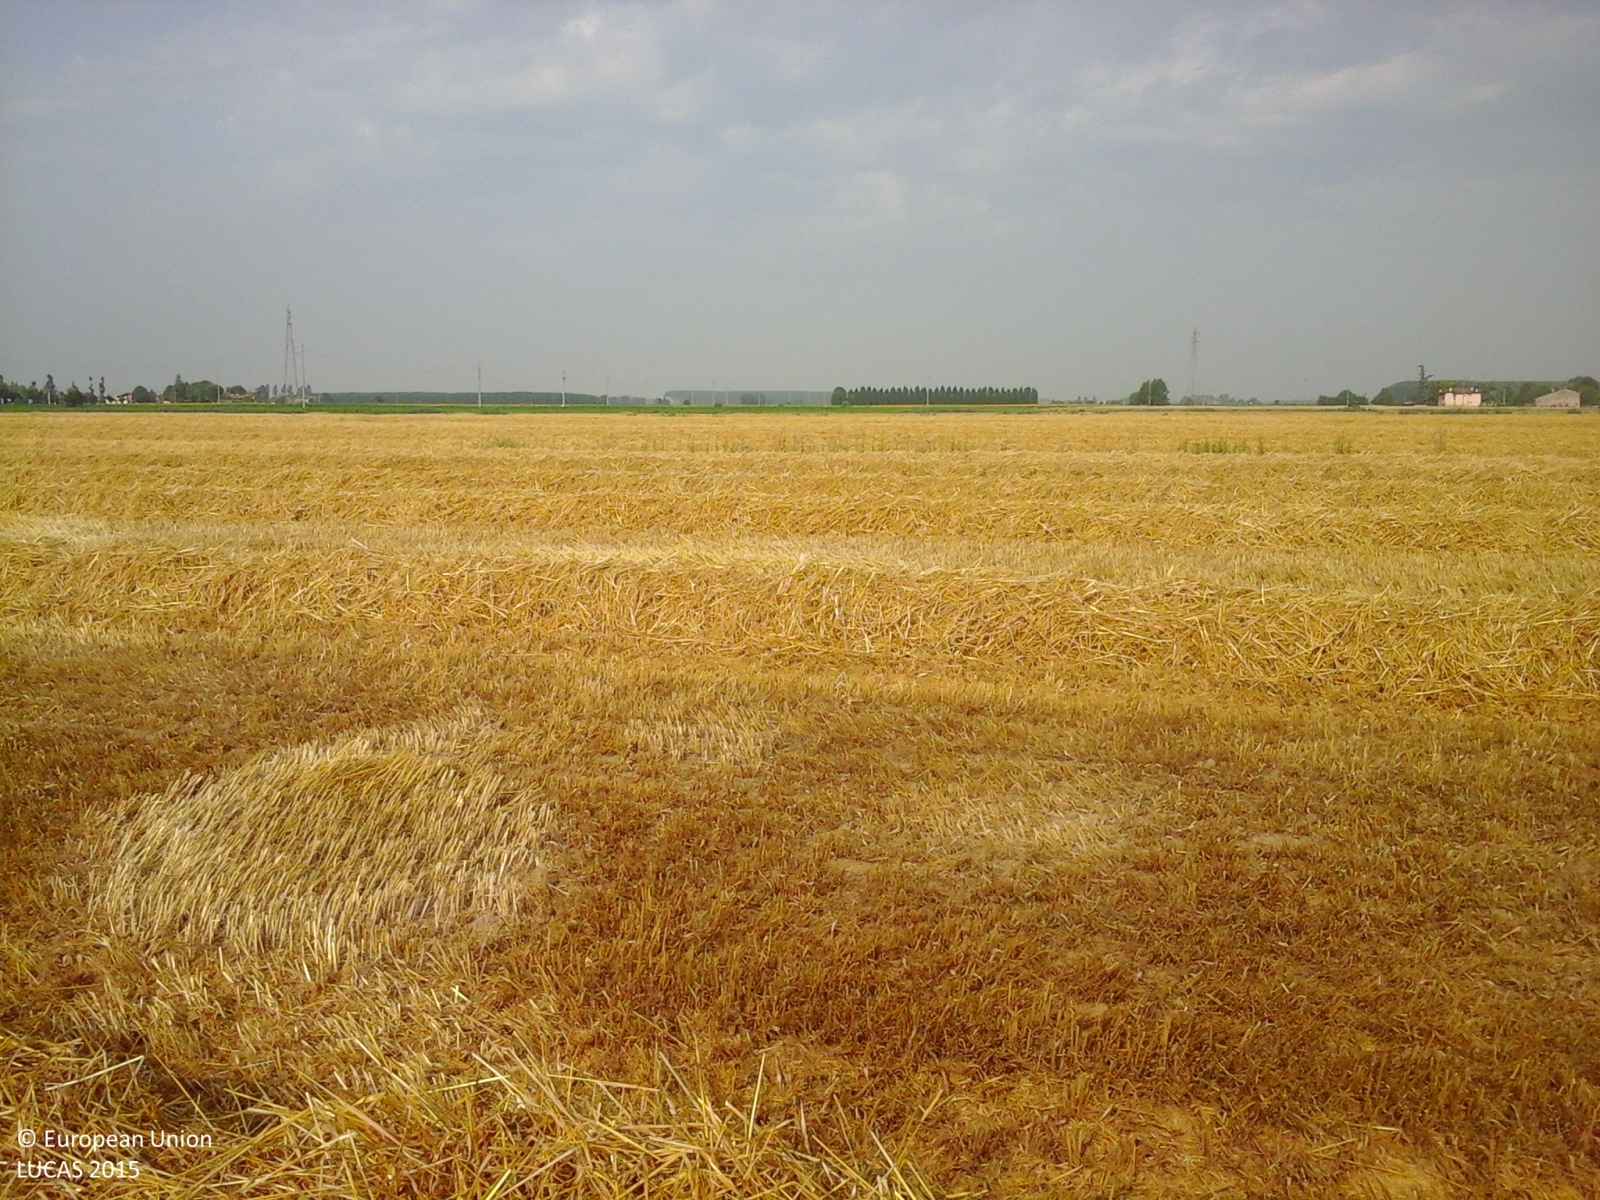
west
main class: Cropland
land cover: Barley
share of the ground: > 75 %
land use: Agriculture (excluding fallow land and kitchen gardens)
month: June
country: IT
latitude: 45.1739
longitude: 11.1304
